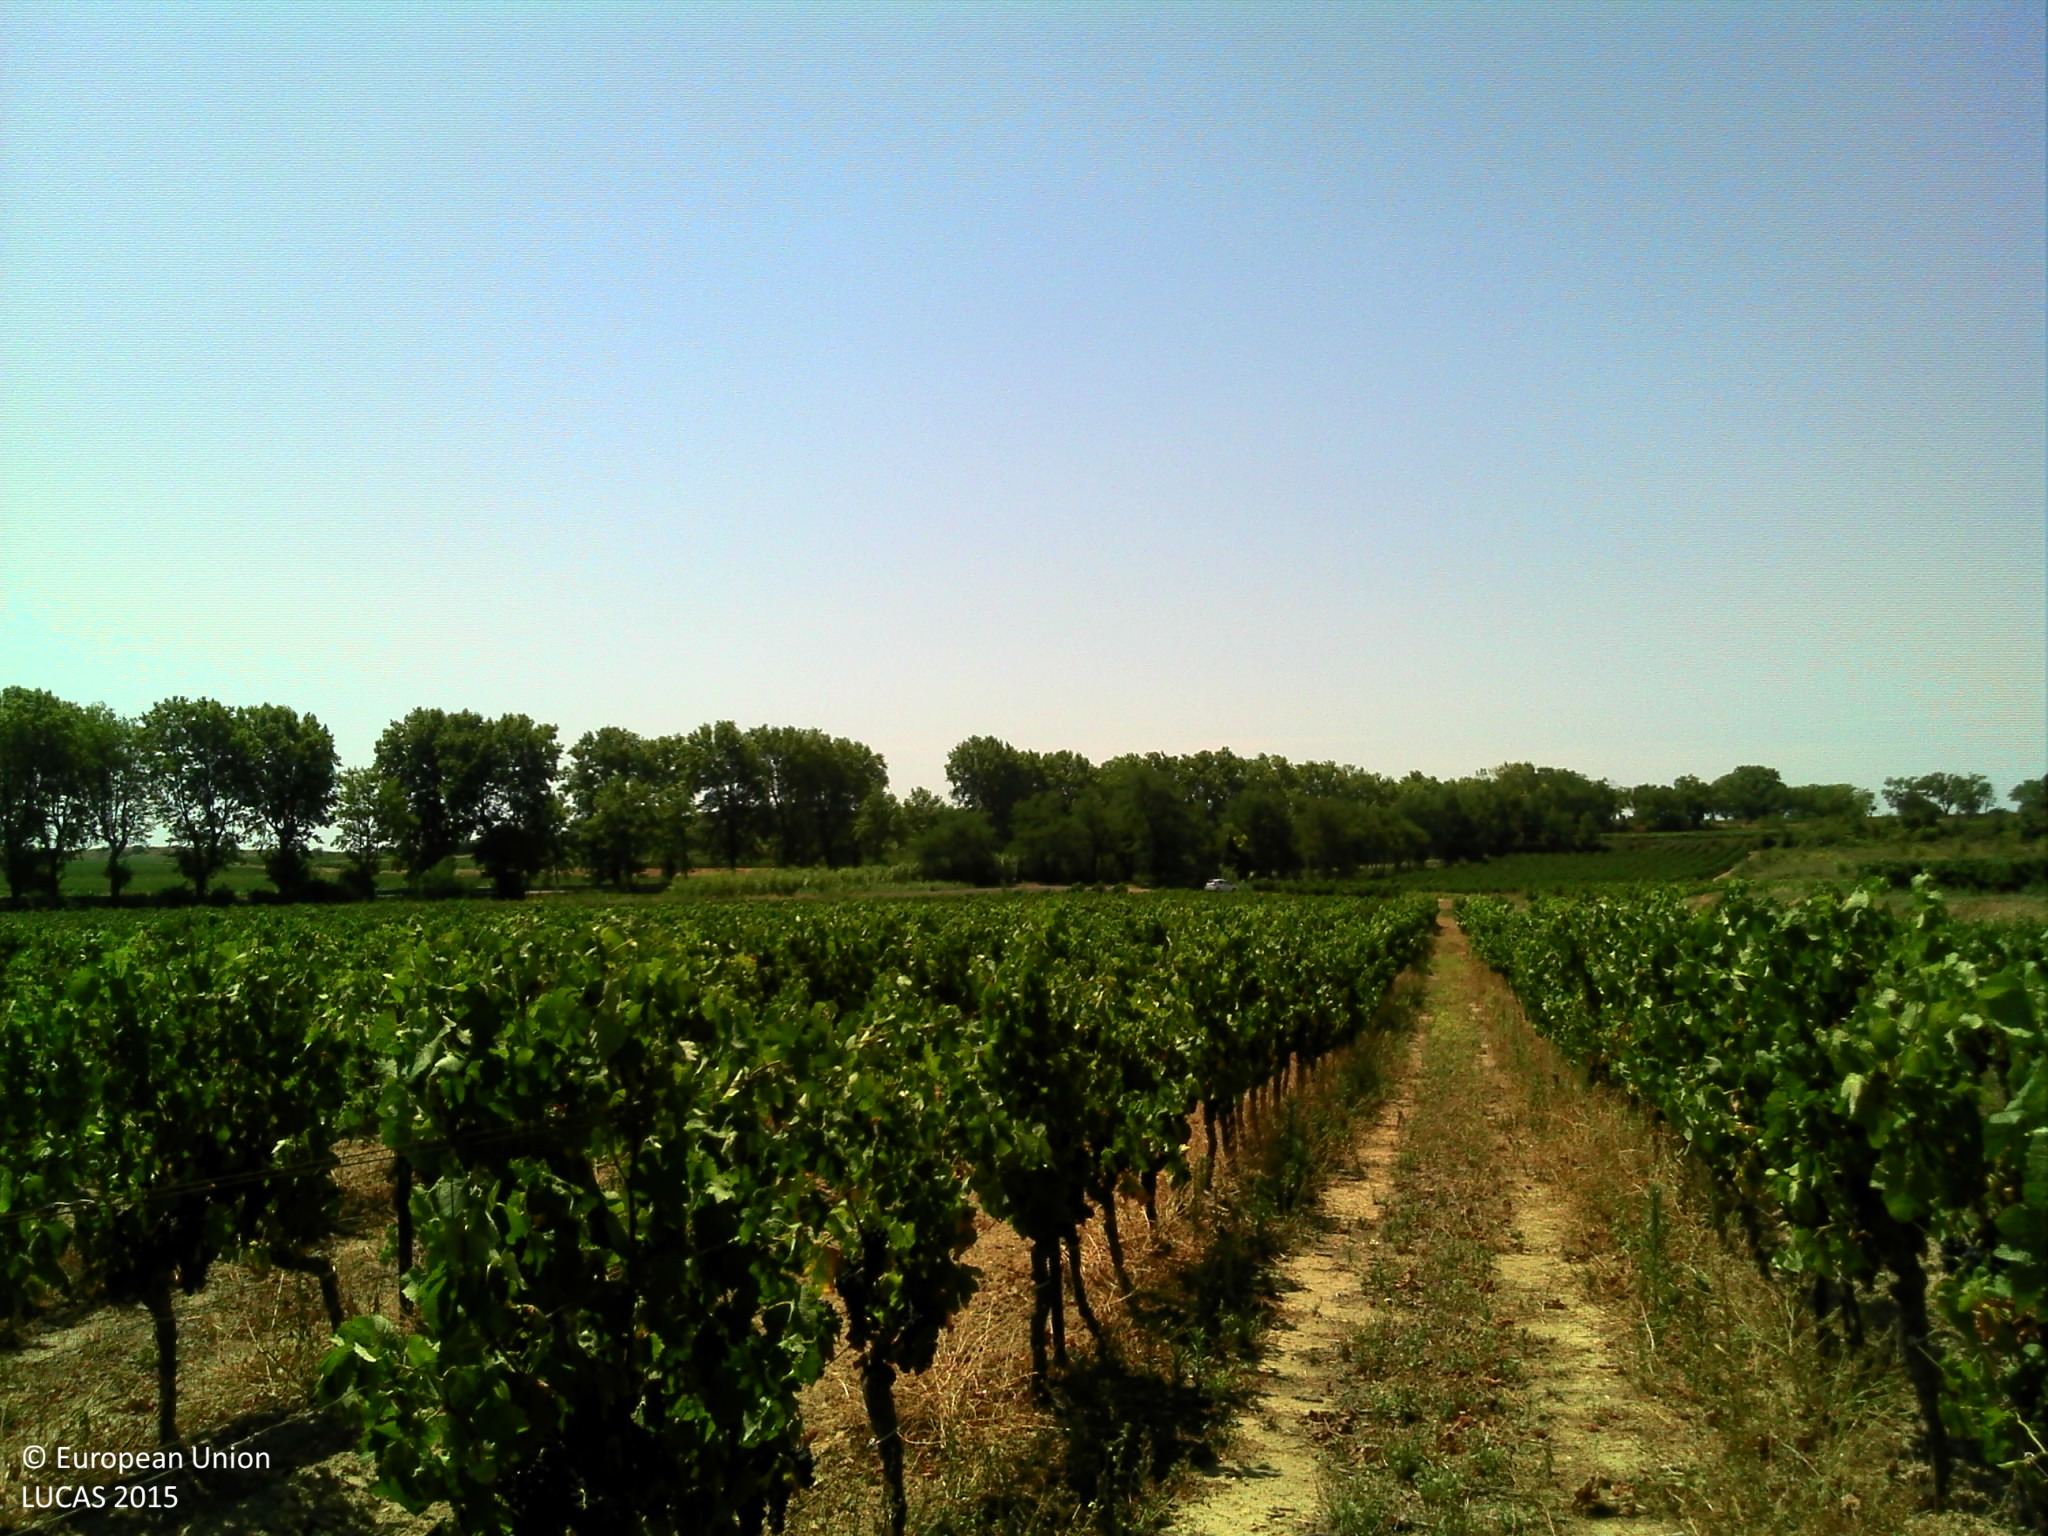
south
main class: Cropland
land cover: Vineyards
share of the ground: 10 - 25 %
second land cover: Other bare soil
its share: > 75 %
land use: Agriculture (excluding fallow land and kitchen gardens)
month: August
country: FR
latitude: 43.4330
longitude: 3.3753
